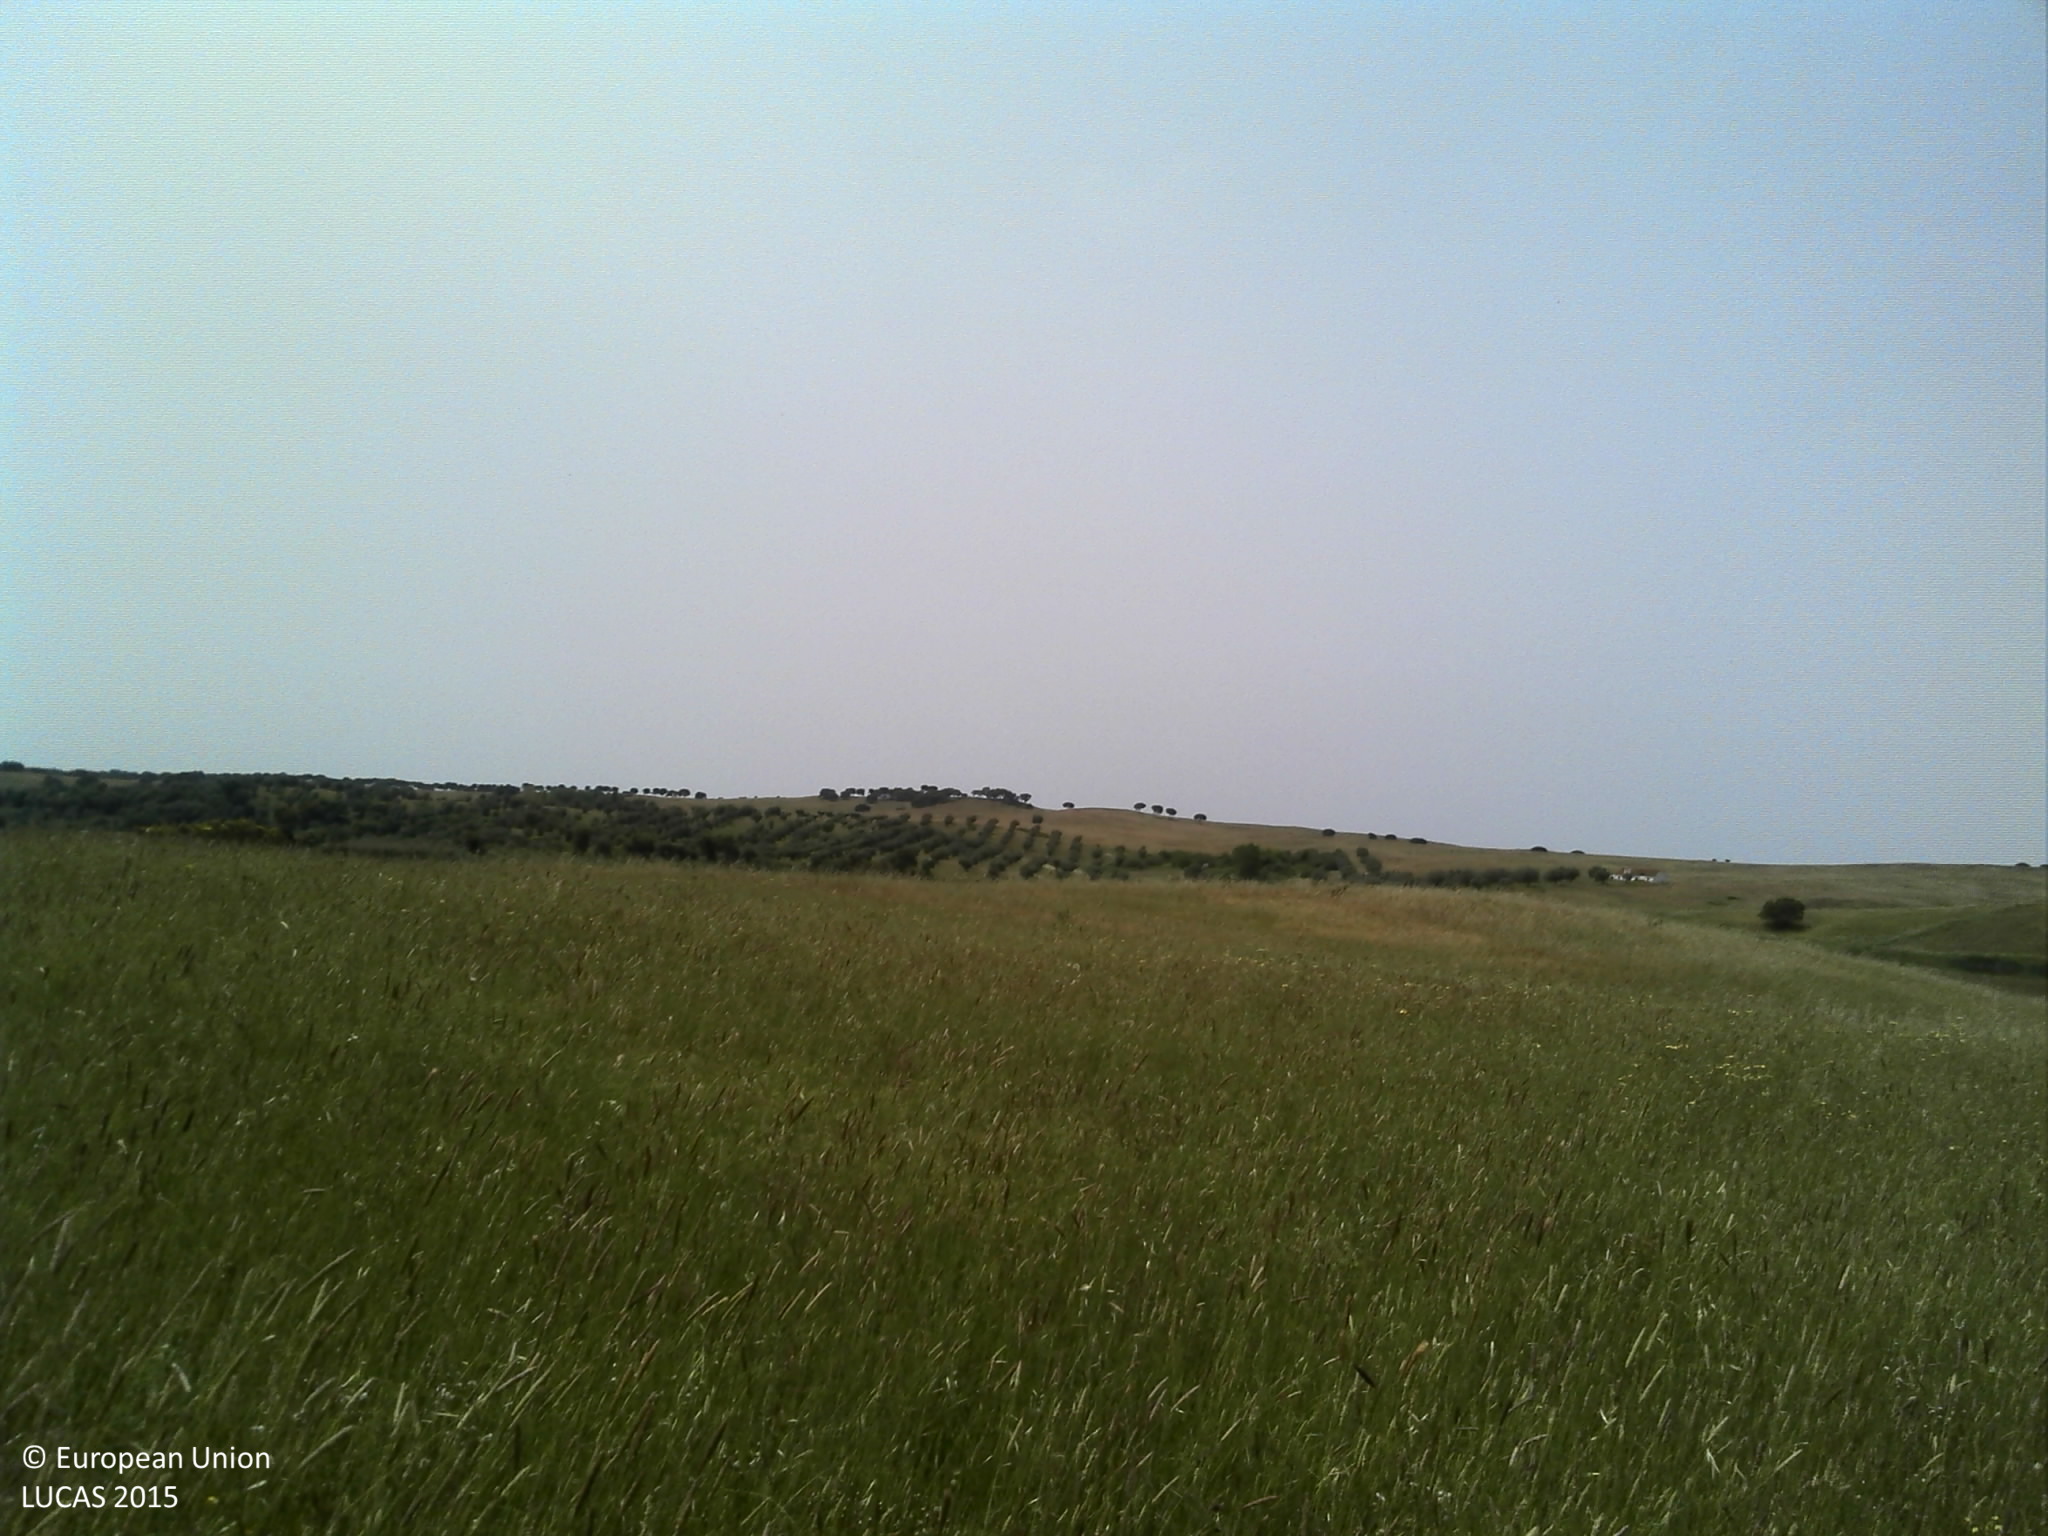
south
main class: Grassland
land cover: Spontaneously vegetated surfaces
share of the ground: > 75 %
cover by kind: herbaceous plants 75 %, unconsolidated bare surface 25 %
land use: Agriculture (excluding fallow land and kitchen gardens)
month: May
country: PT
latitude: 38.4642
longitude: -8.4453
